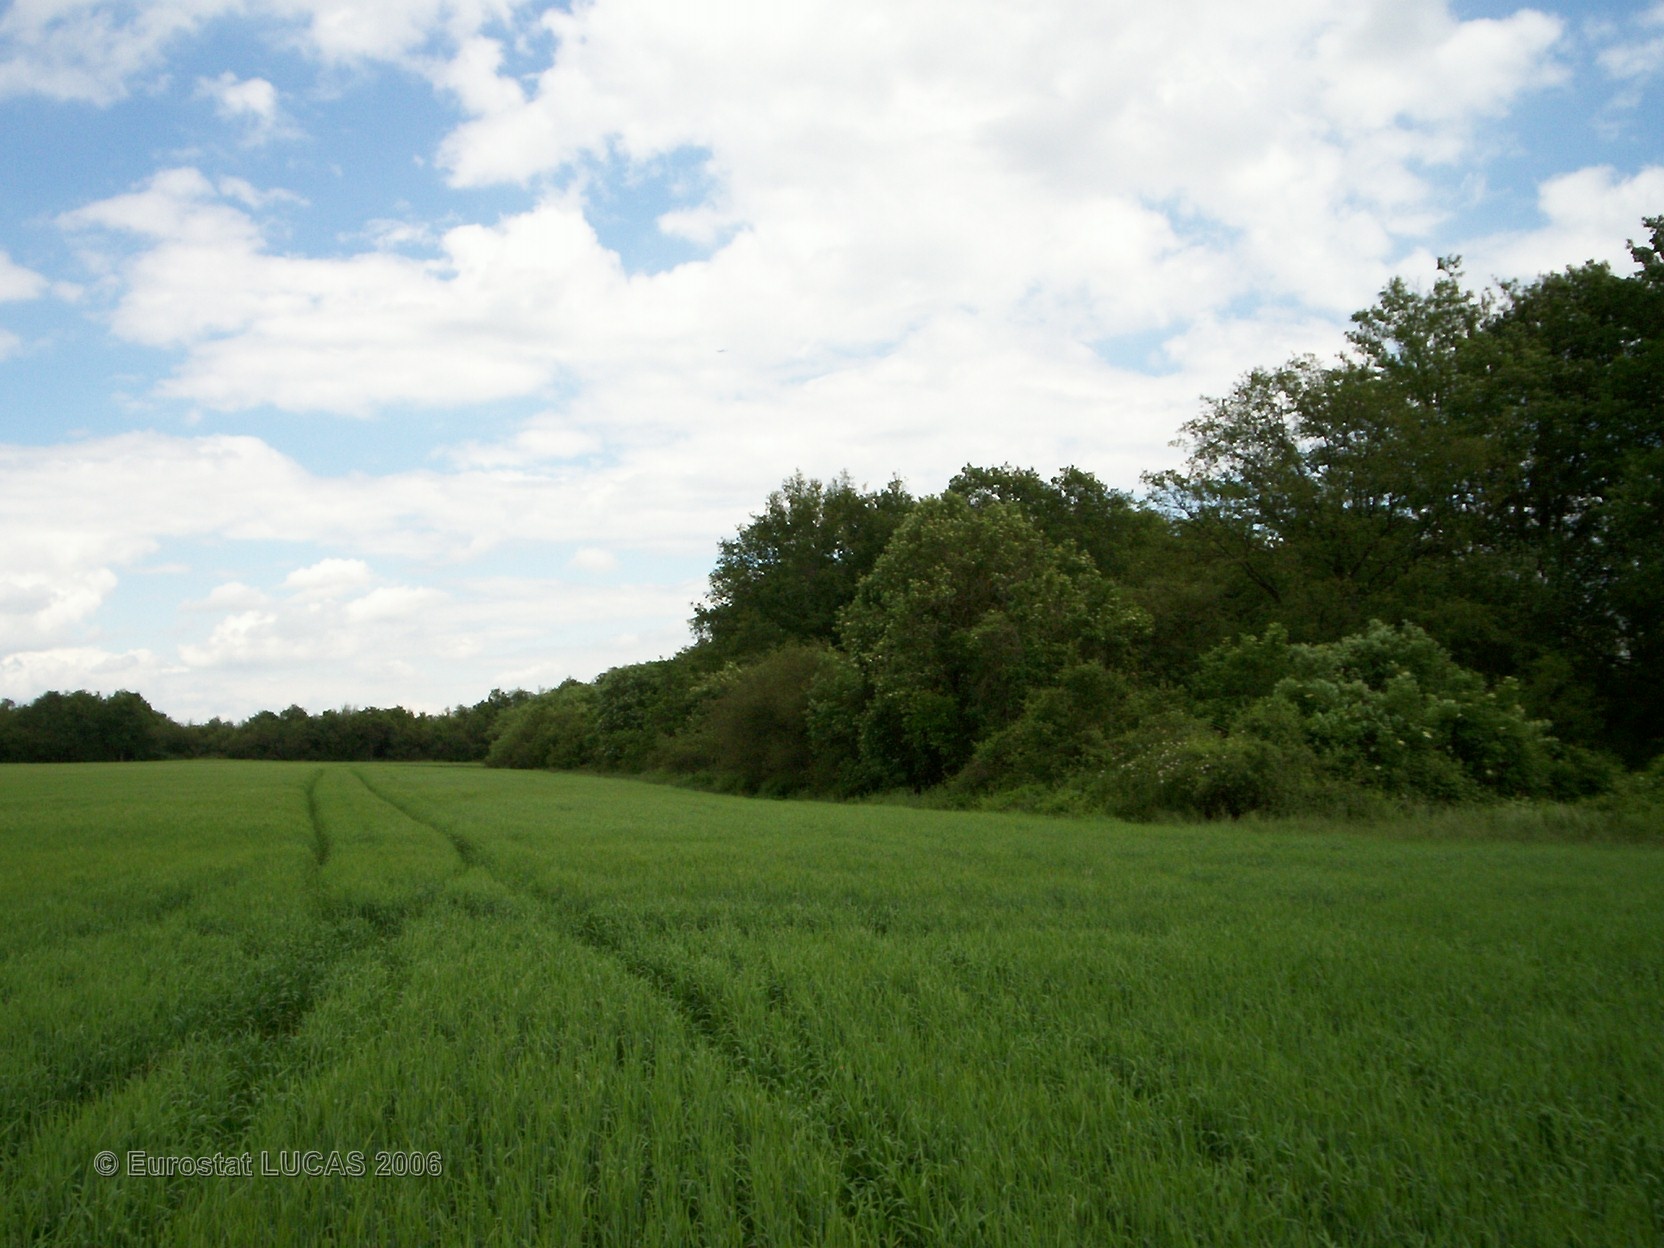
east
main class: Cropland
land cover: Barley
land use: Agriculture (excluding fallow land and kitchen gardens)
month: May
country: FR
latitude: 48.5675
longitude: 2.8220
